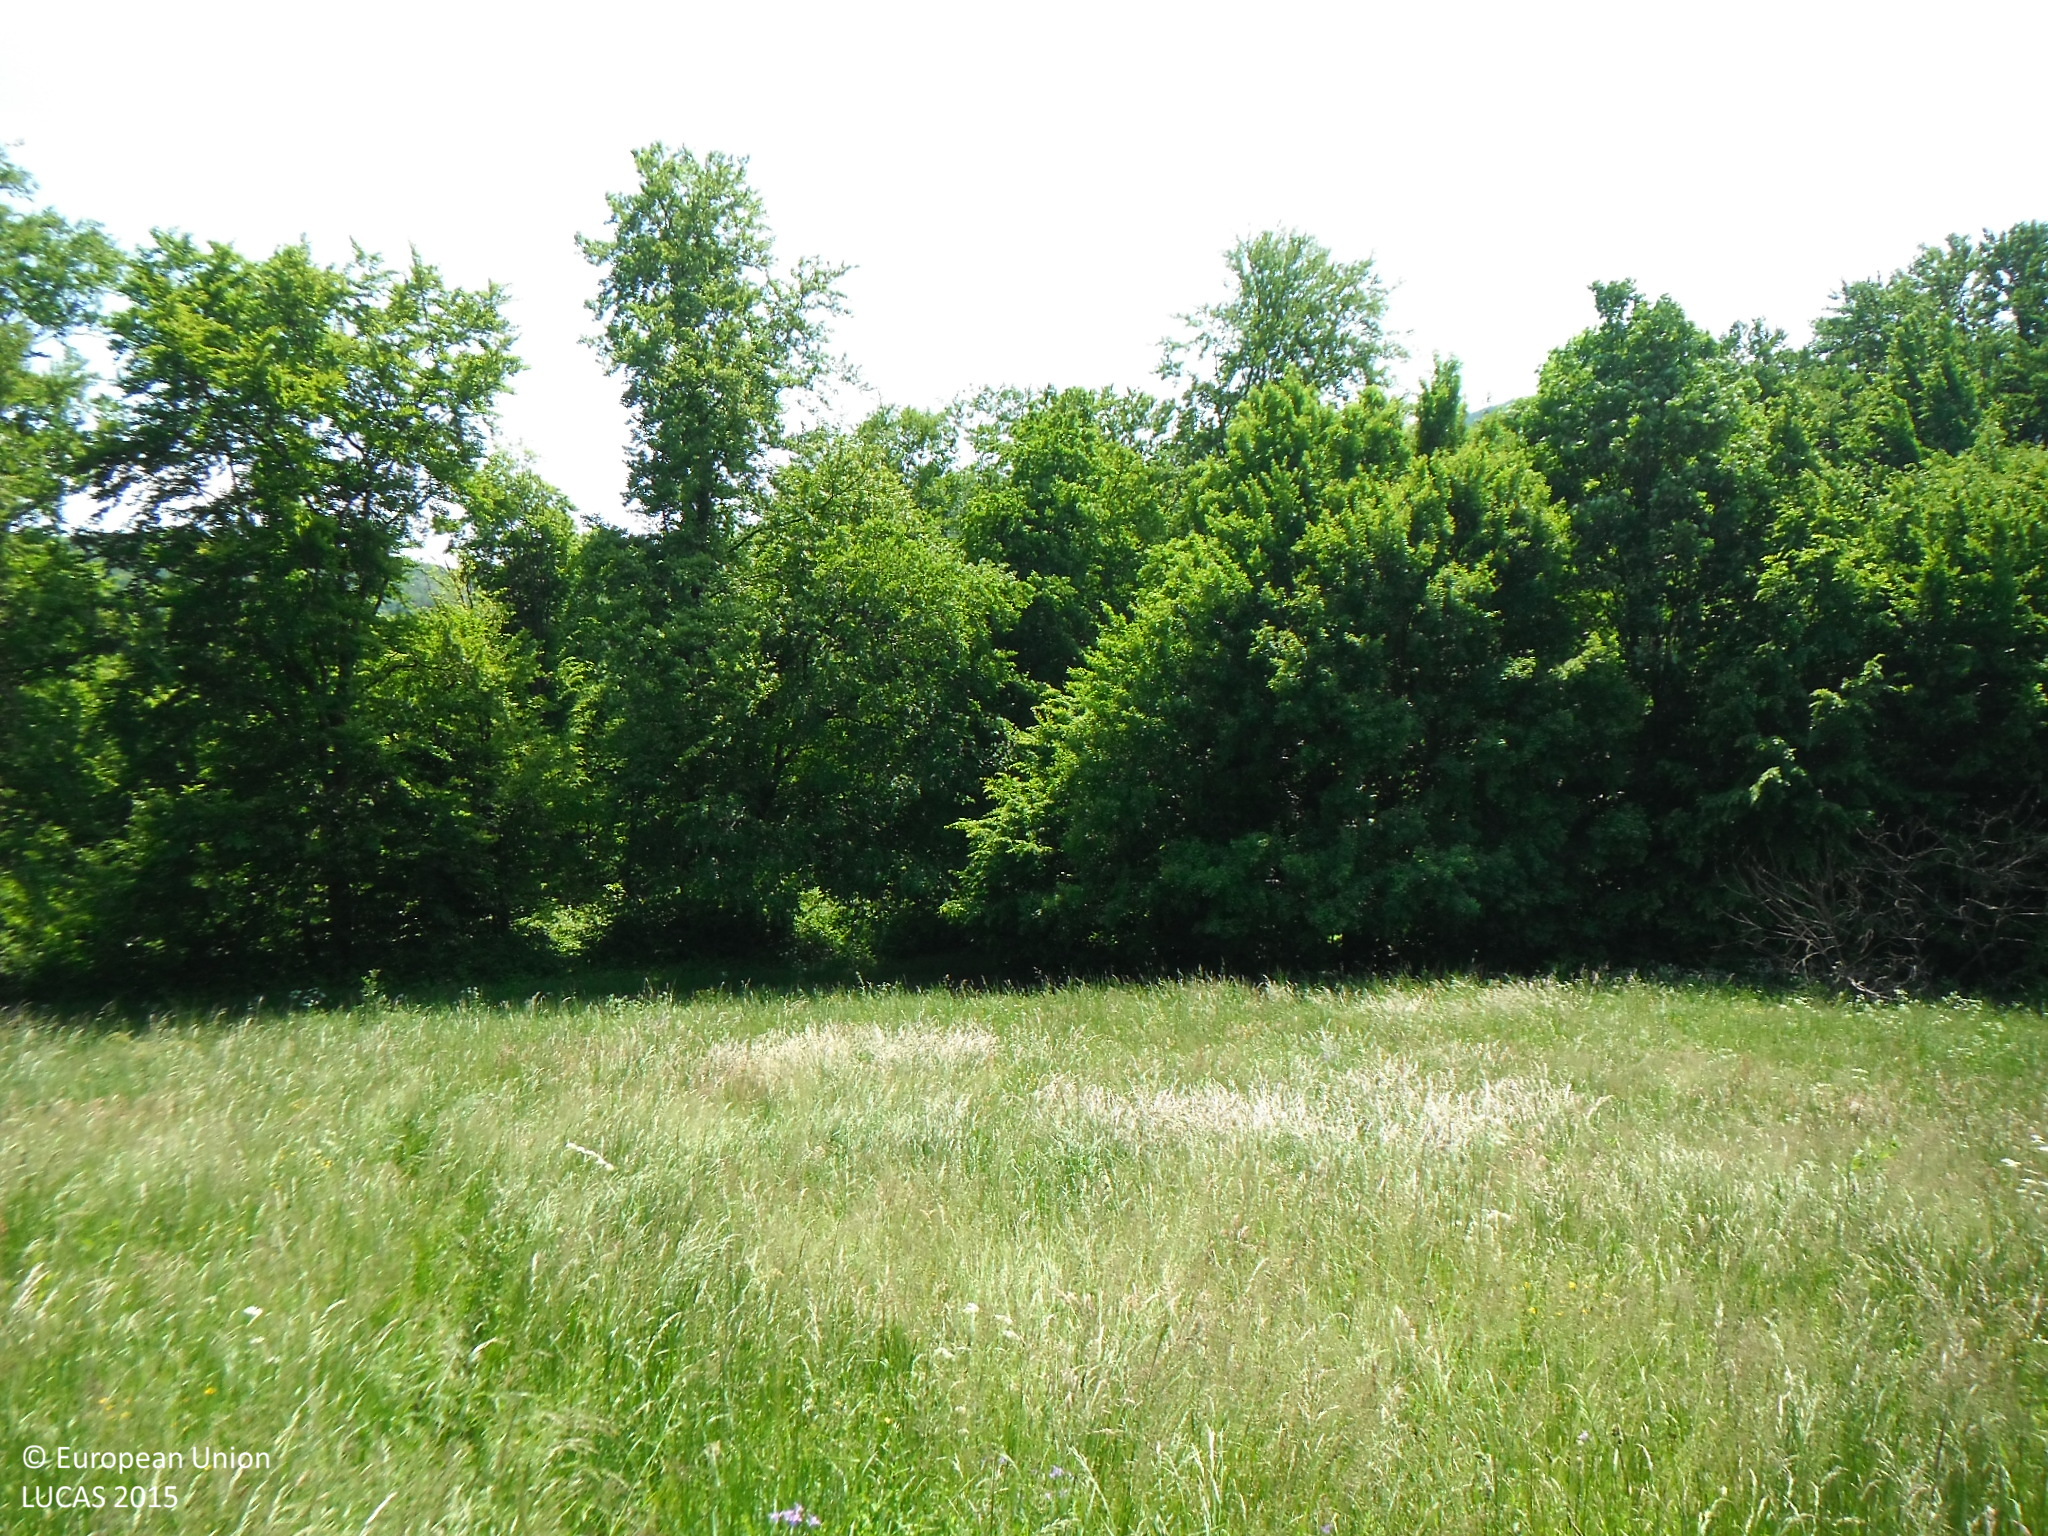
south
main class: Grassland
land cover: Grassland without tree/shrub cover
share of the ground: > 75 %
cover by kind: herbaceous plants 100 %
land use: Agriculture (excluding fallow land and kitchen gardens)
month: June
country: SK
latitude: 48.7835
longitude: 21.1351
